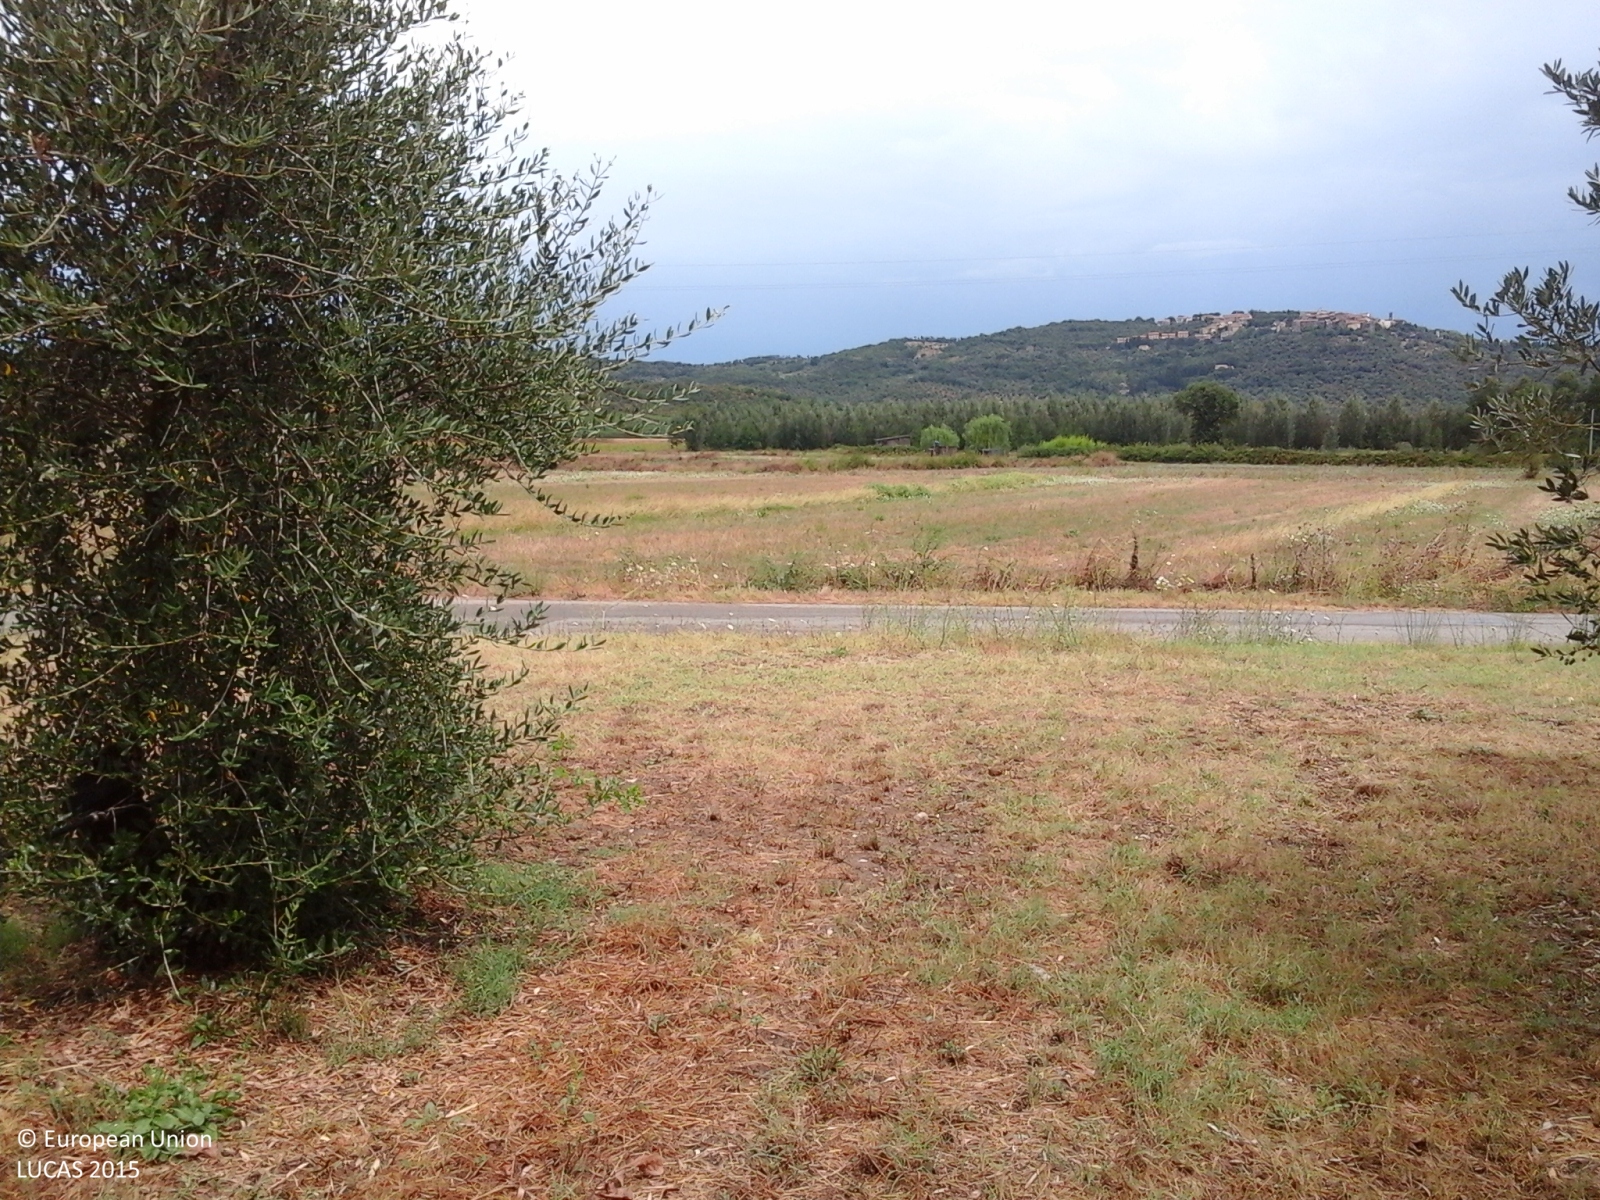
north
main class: Cropland
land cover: Olive groves
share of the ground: 50 - 75 %
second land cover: Grassland without tree/shrub cover
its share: 10 - 25 %
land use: Agriculture (excluding fallow land and kitchen gardens)
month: August
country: IT
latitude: 42.8840
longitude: 10.9886
